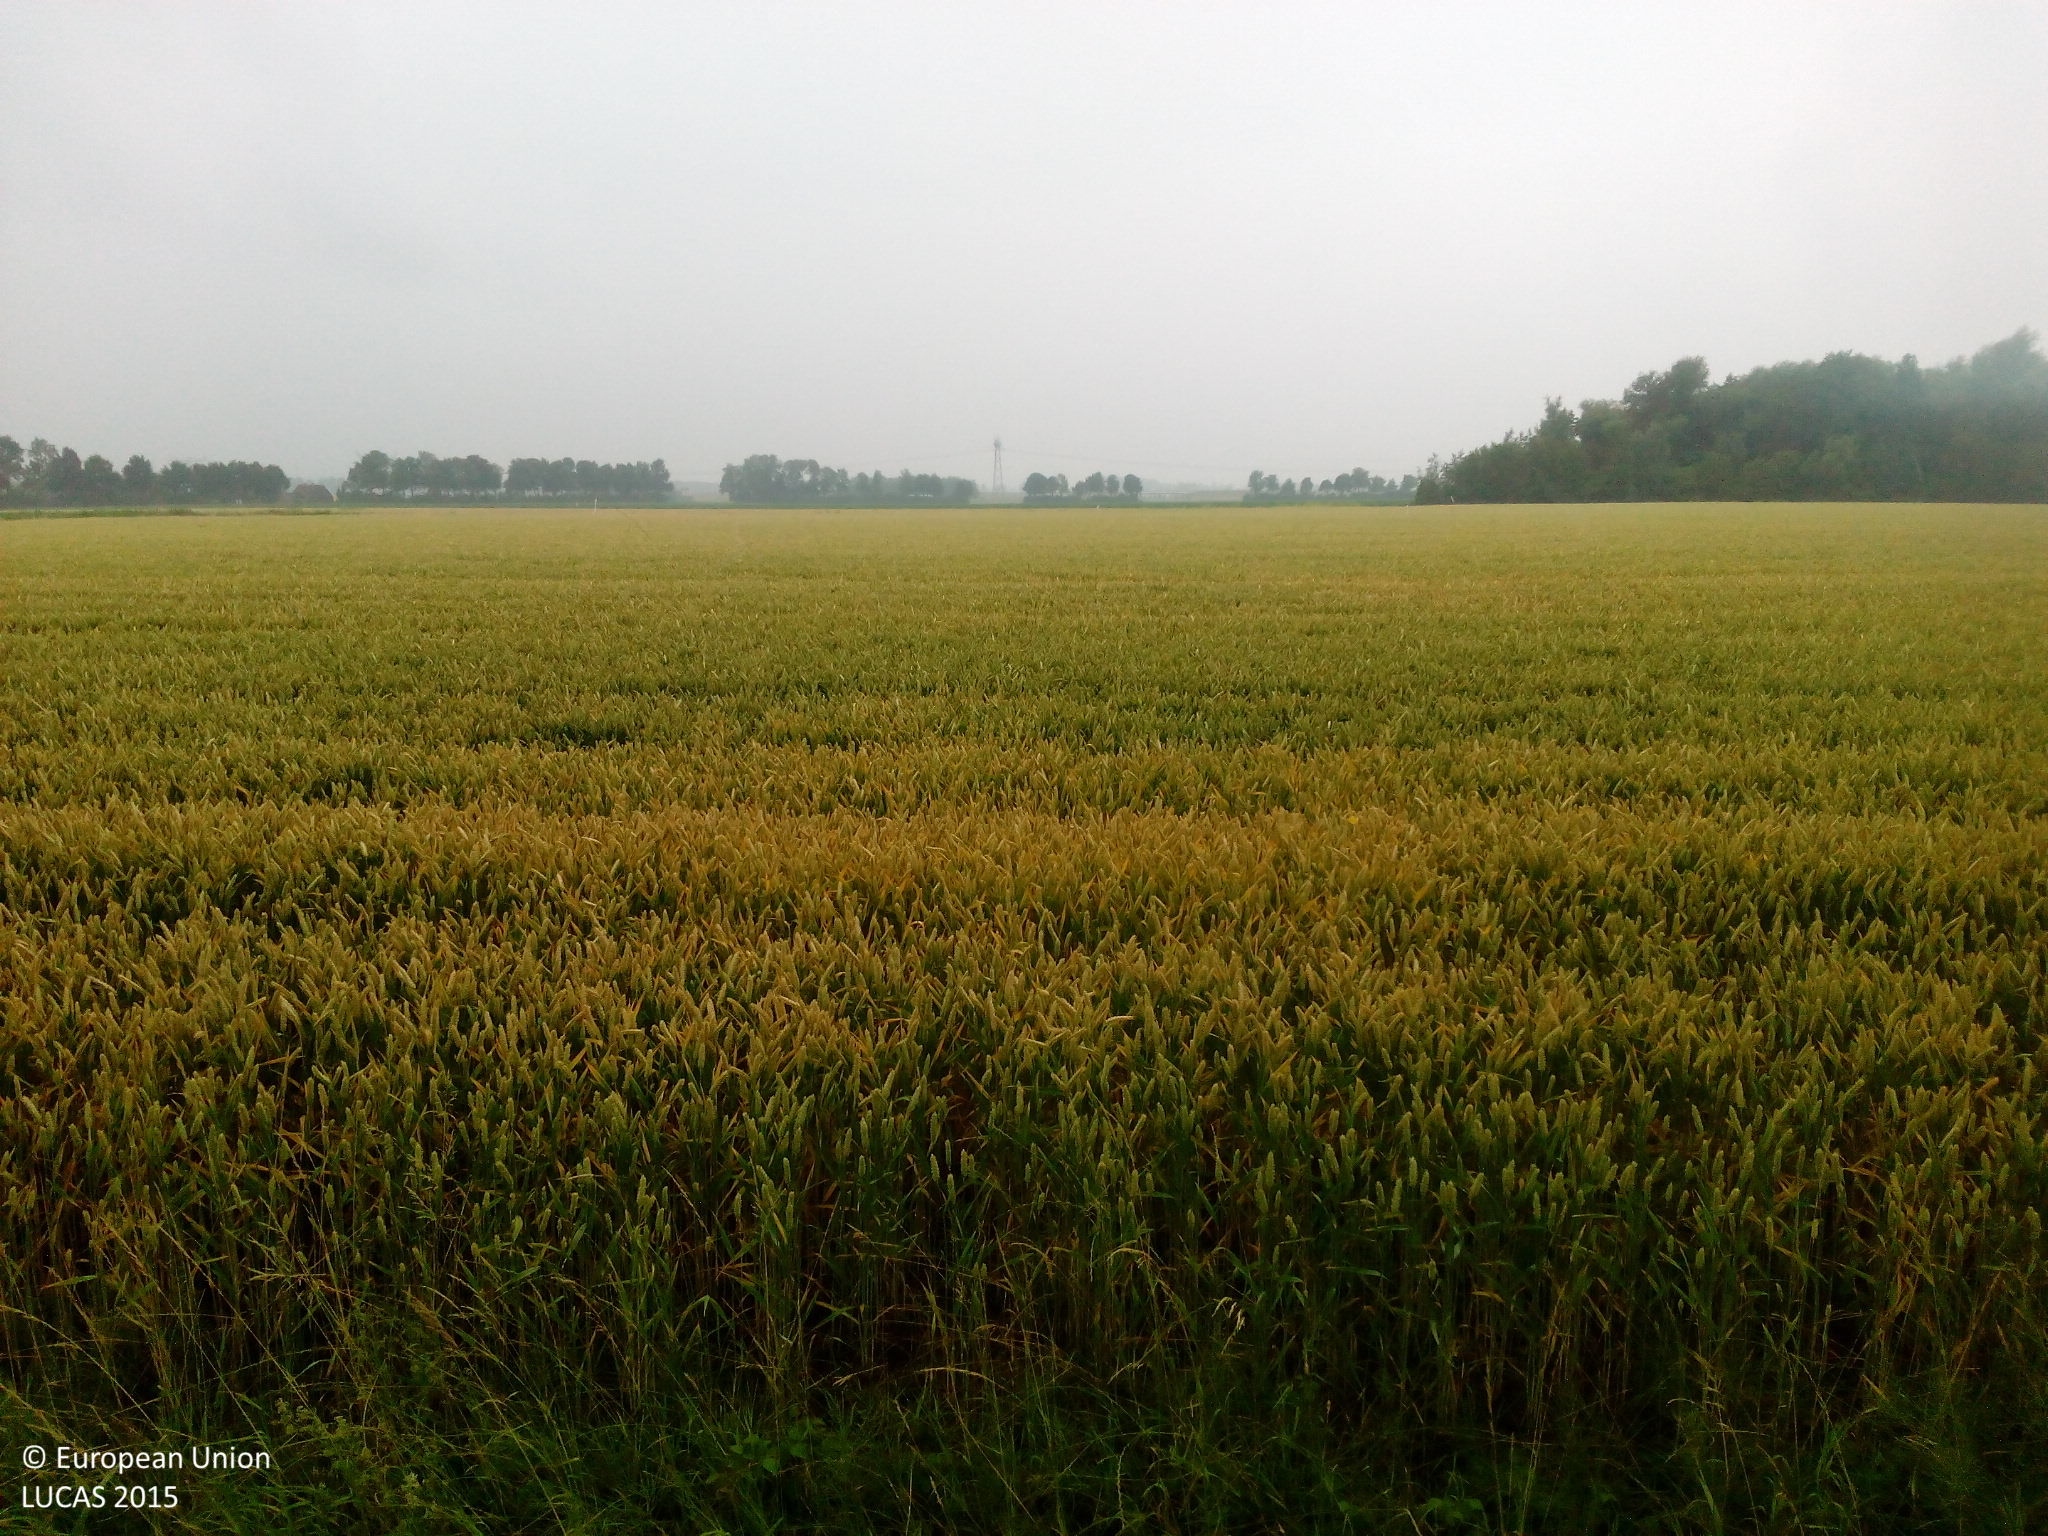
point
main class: Cropland
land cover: Common wheat
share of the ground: > 75 %
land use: Agriculture (excluding fallow land and kitchen gardens)
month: July
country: NL
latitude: 51.8681
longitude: 5.7143
